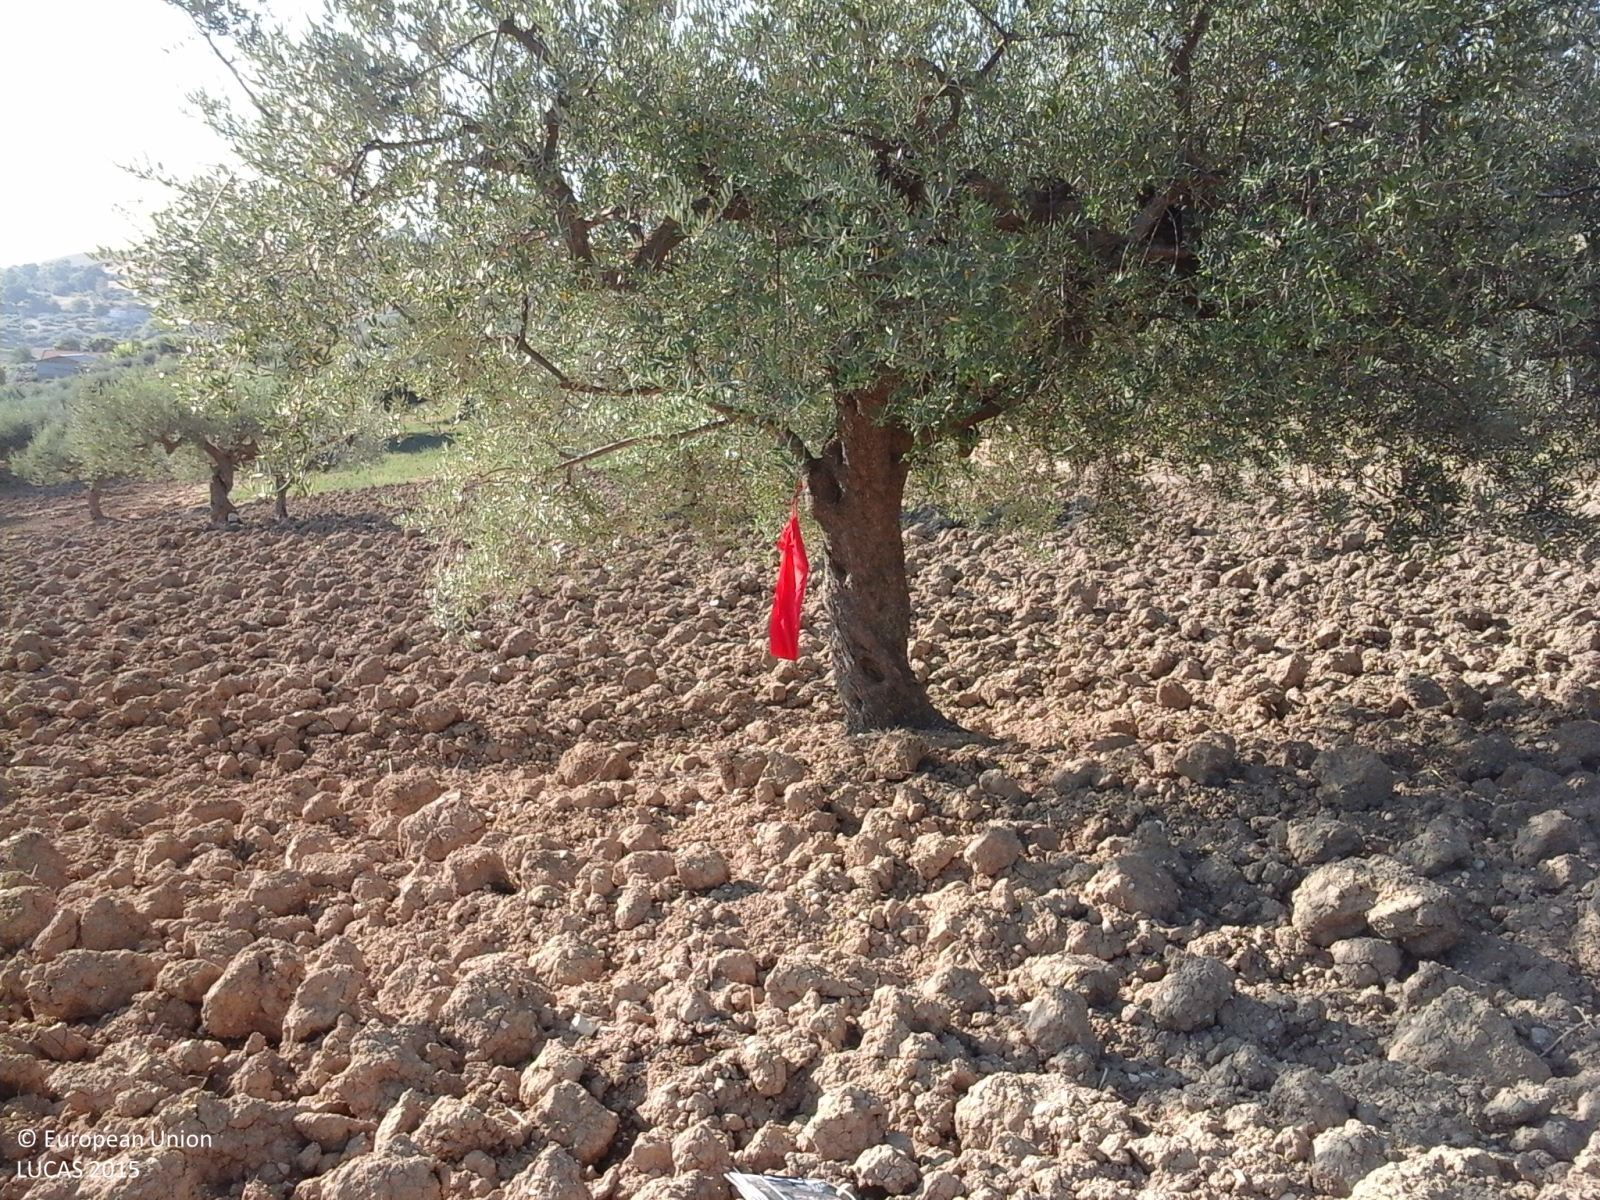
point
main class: Cropland
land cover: Olive groves
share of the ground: < 10 %
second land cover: Durum wheat
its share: > 75 %
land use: Agriculture (excluding fallow land and kitchen gardens)
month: August
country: IT
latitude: 42.5913
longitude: 14.0463
